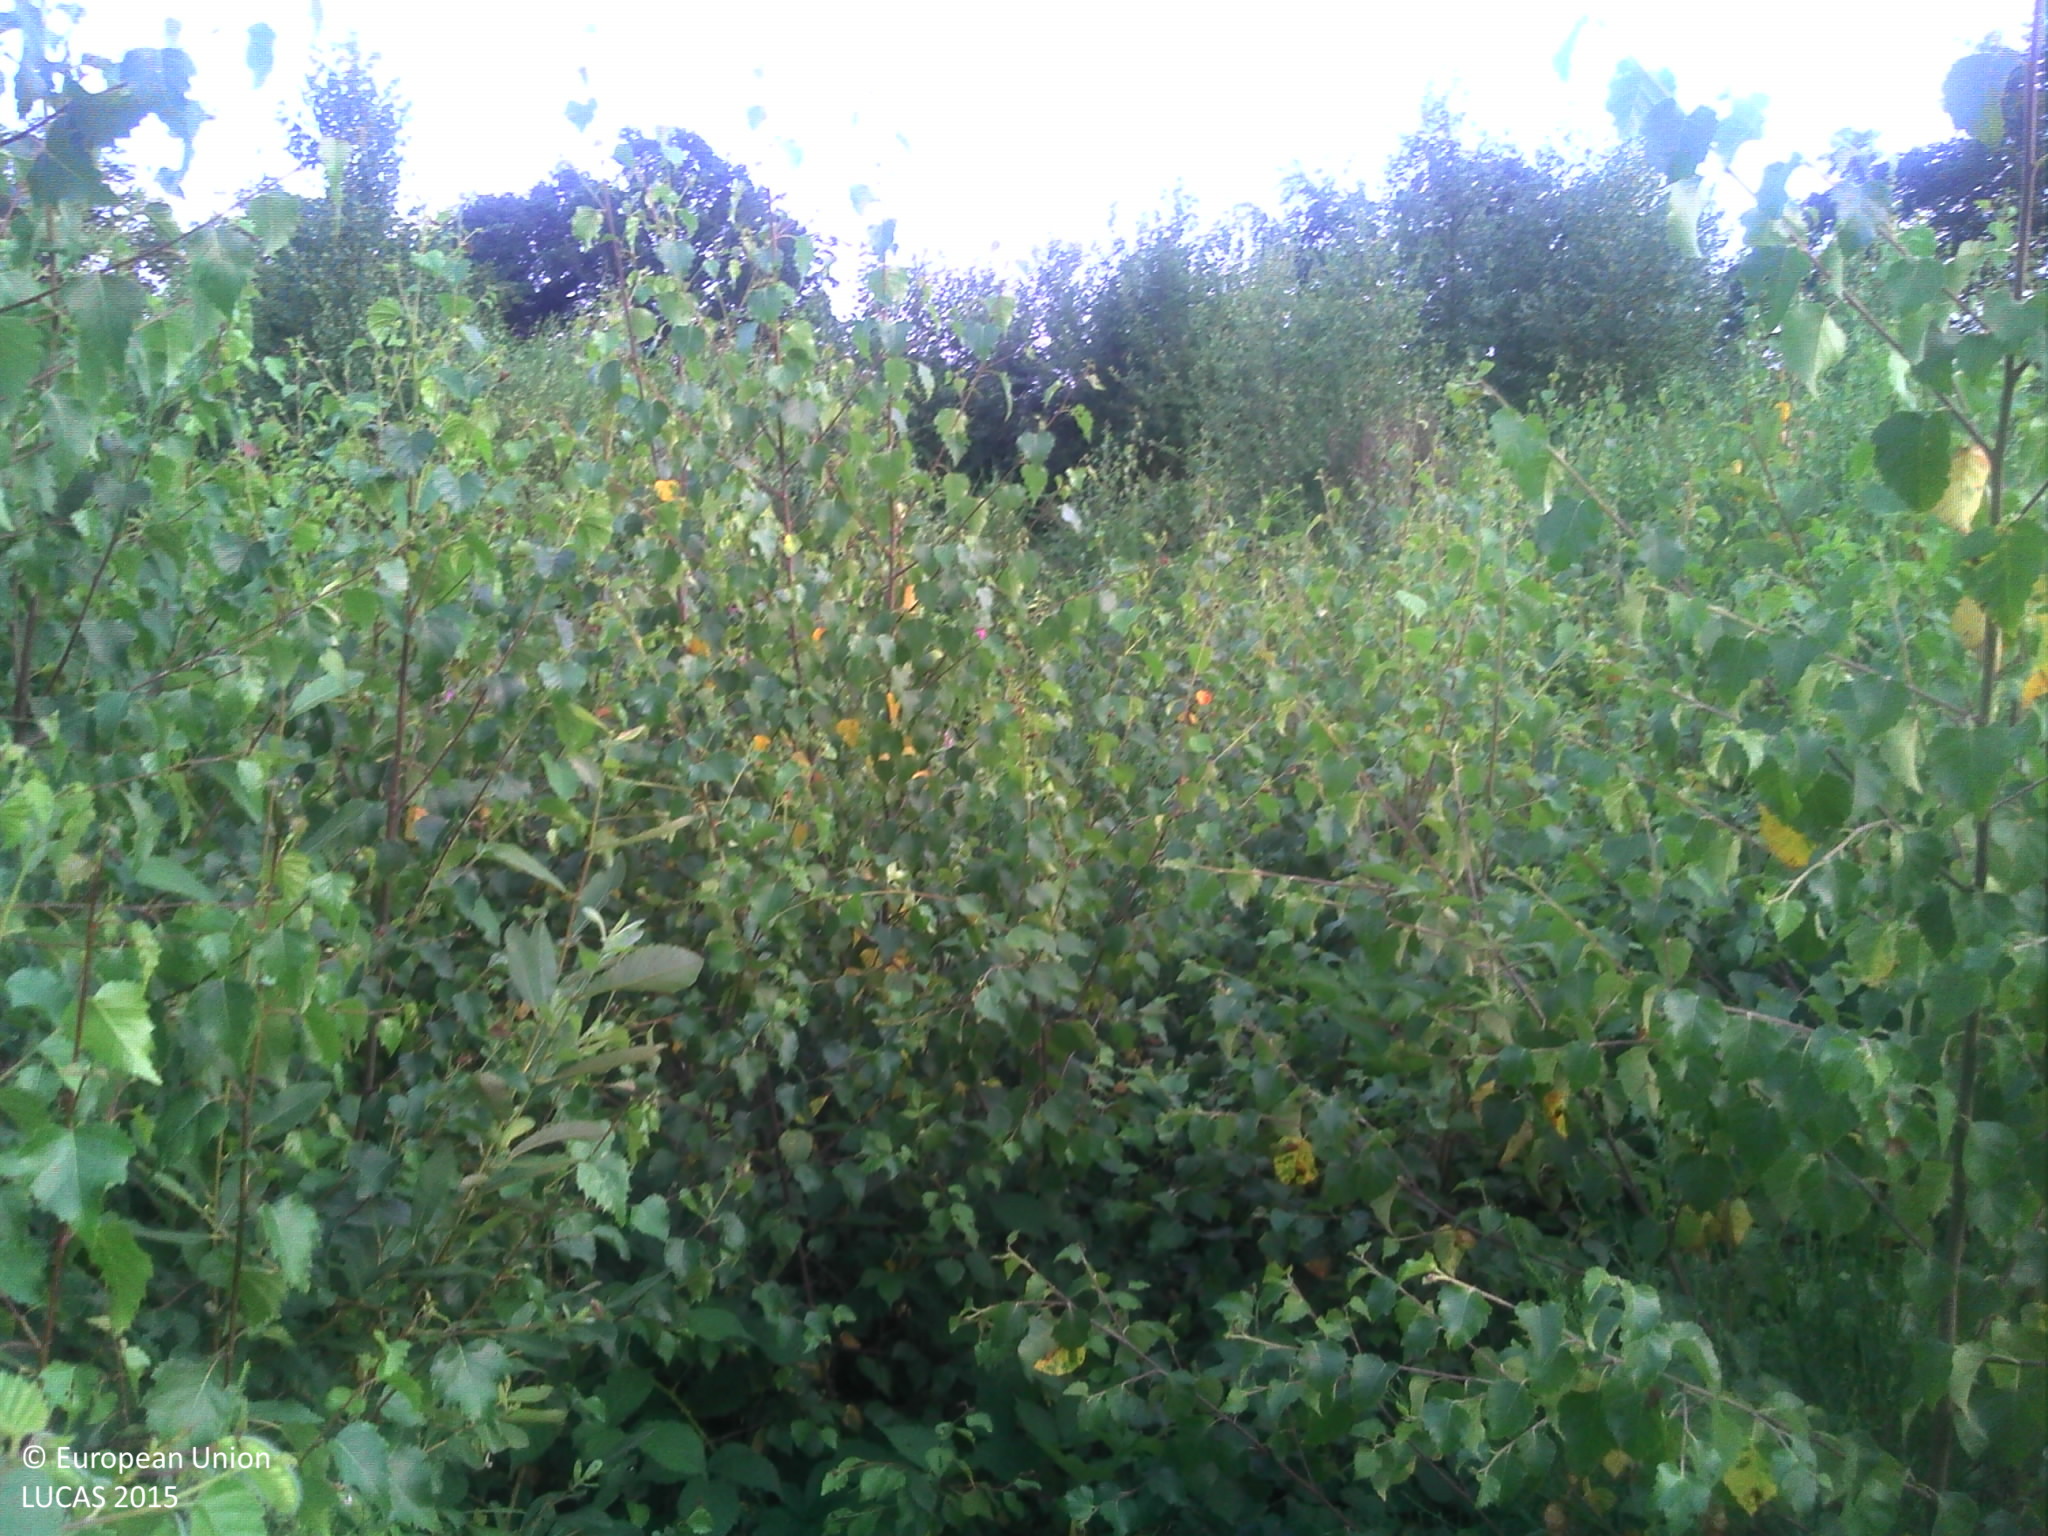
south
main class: Grassland
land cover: Spontaneously vegetated surfaces
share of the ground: > 75 %
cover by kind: herbaceous plants 95 %, shrubs 5 %
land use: Semi-natural and natural areas not in use
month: July
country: FR
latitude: 48.8763
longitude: 0.4429
